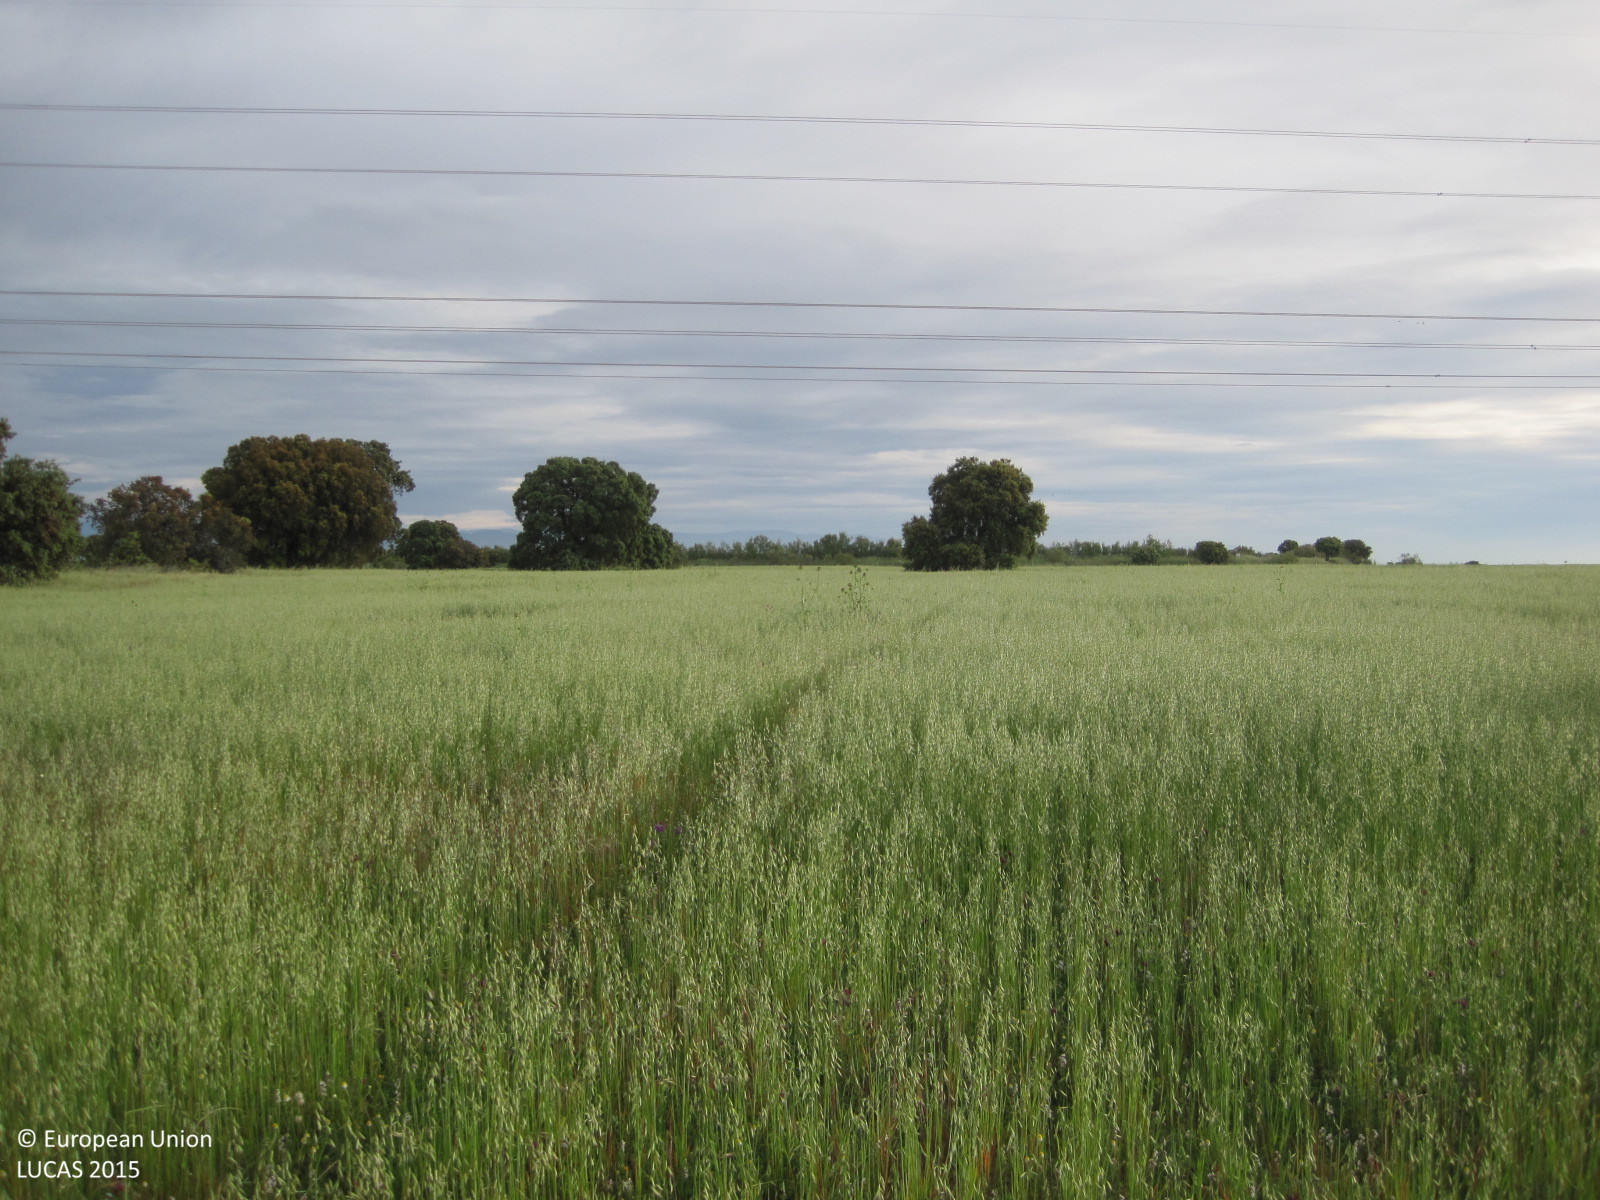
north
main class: Cropland
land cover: Oats
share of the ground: > 75 %
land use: Agriculture (excluding fallow land and kitchen gardens)
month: May
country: ES
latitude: 39.8347
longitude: -4.6851
